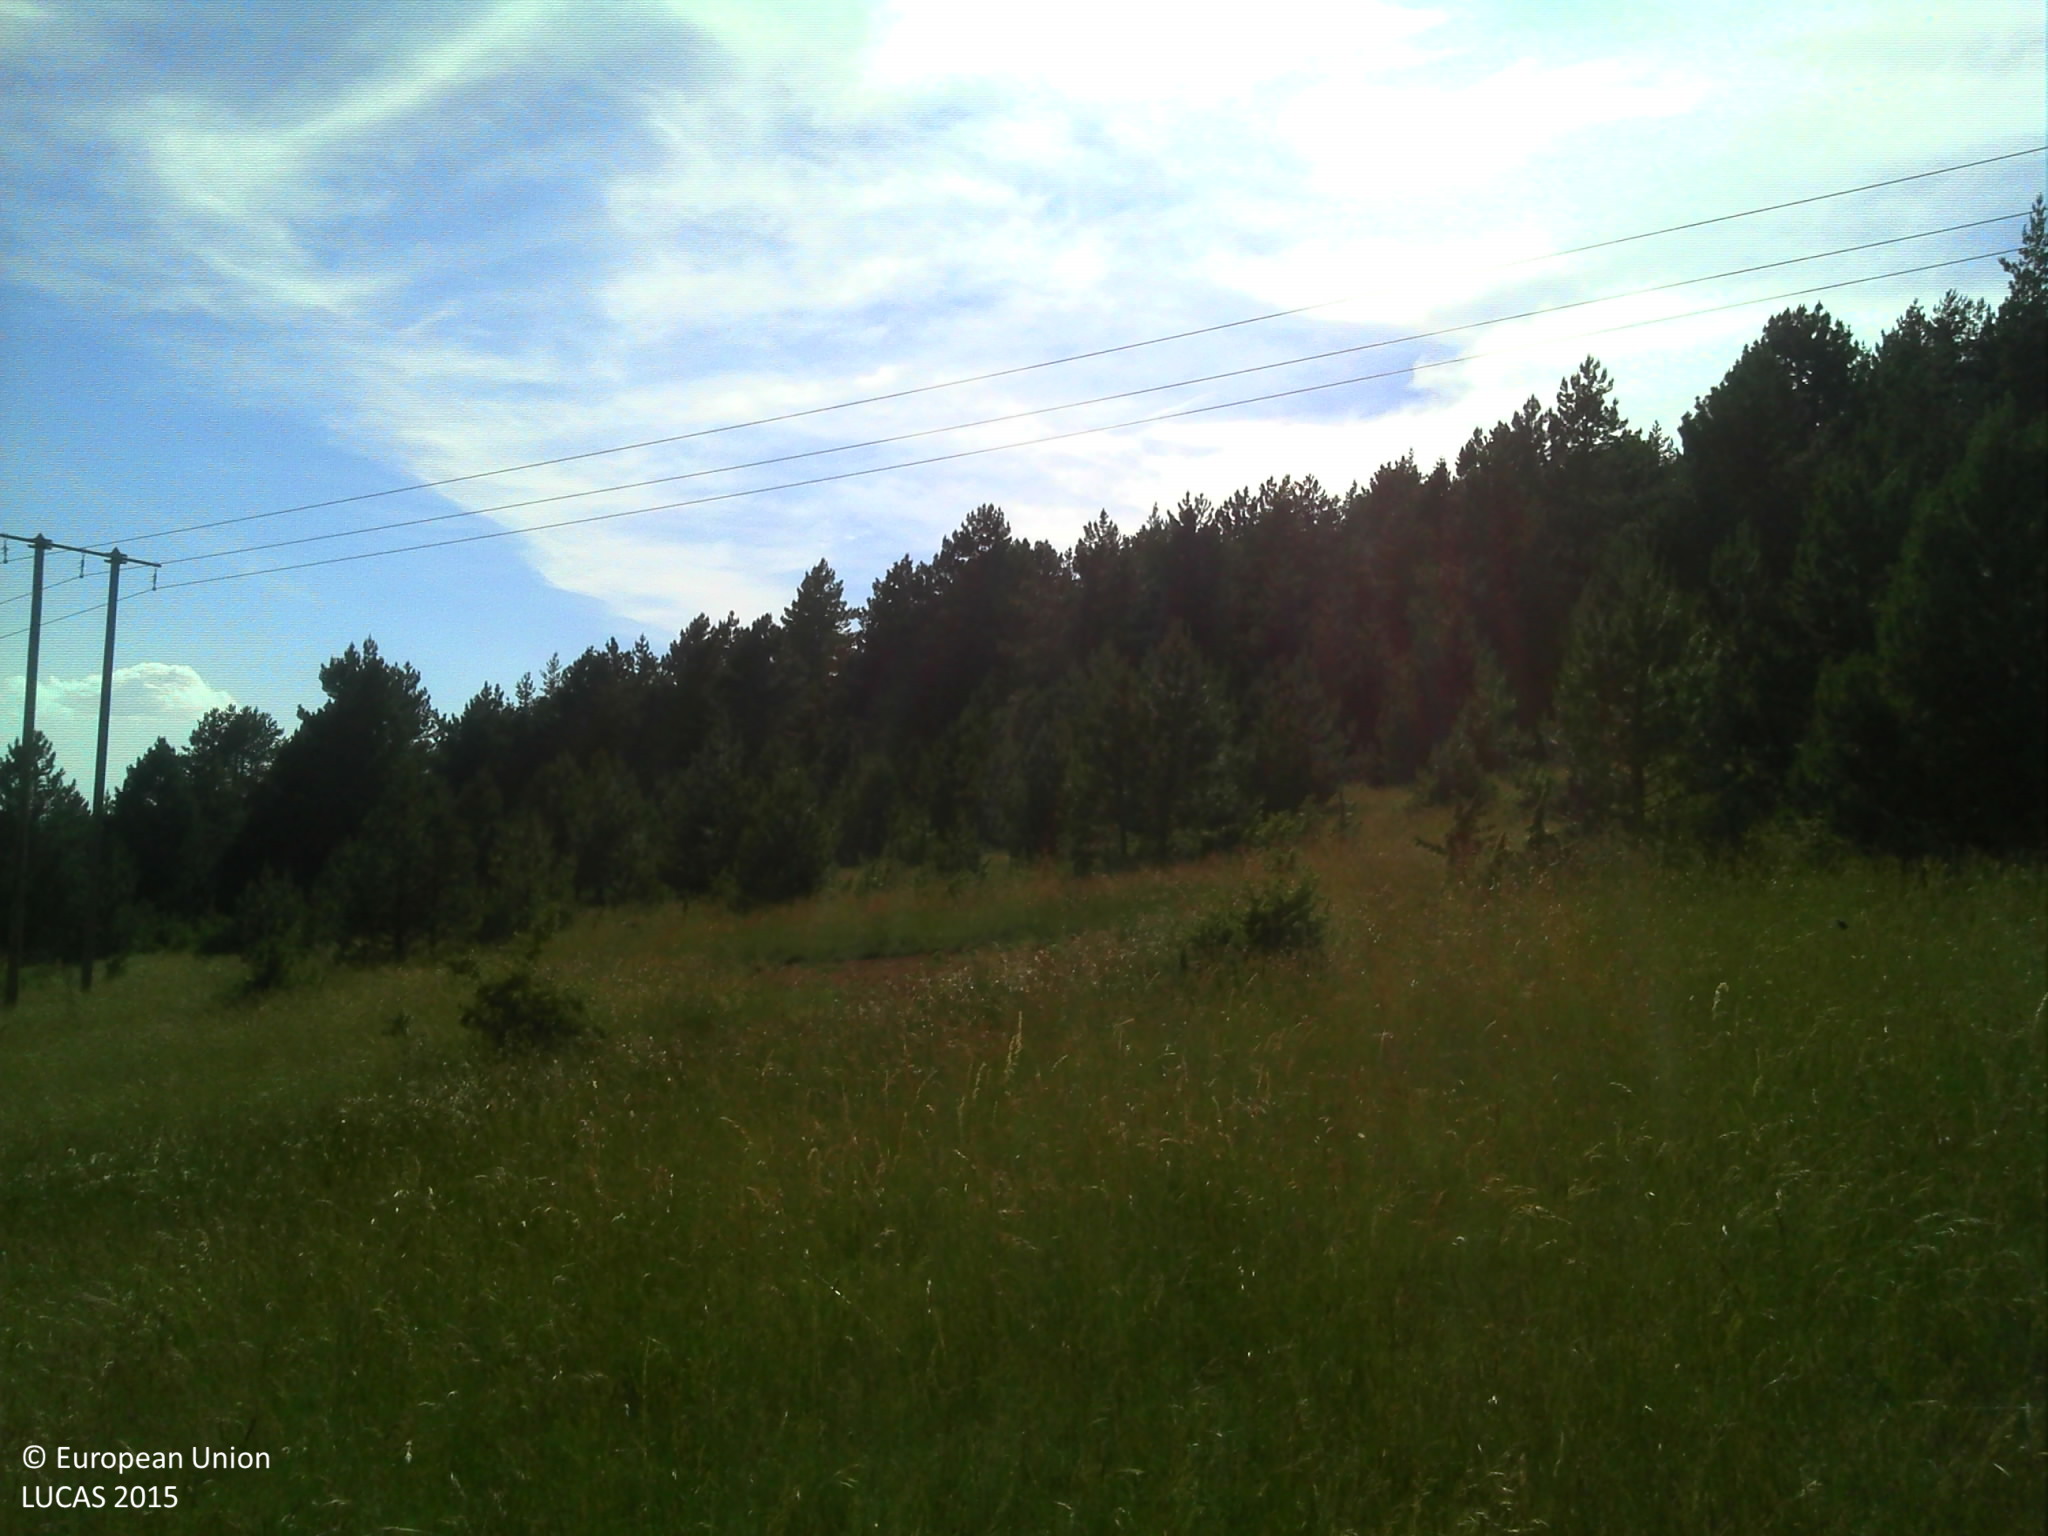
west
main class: Grassland
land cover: Grassland with sparse tree/shrub cover
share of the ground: > 75 %
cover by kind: herbaceous plants 90 %, coniferous forest trees 5 %, shrubs 5 %
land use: Agriculture (excluding fallow land and kitchen gardens)
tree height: < 5 m
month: June
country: FR
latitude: 44.5117
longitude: 3.5520
